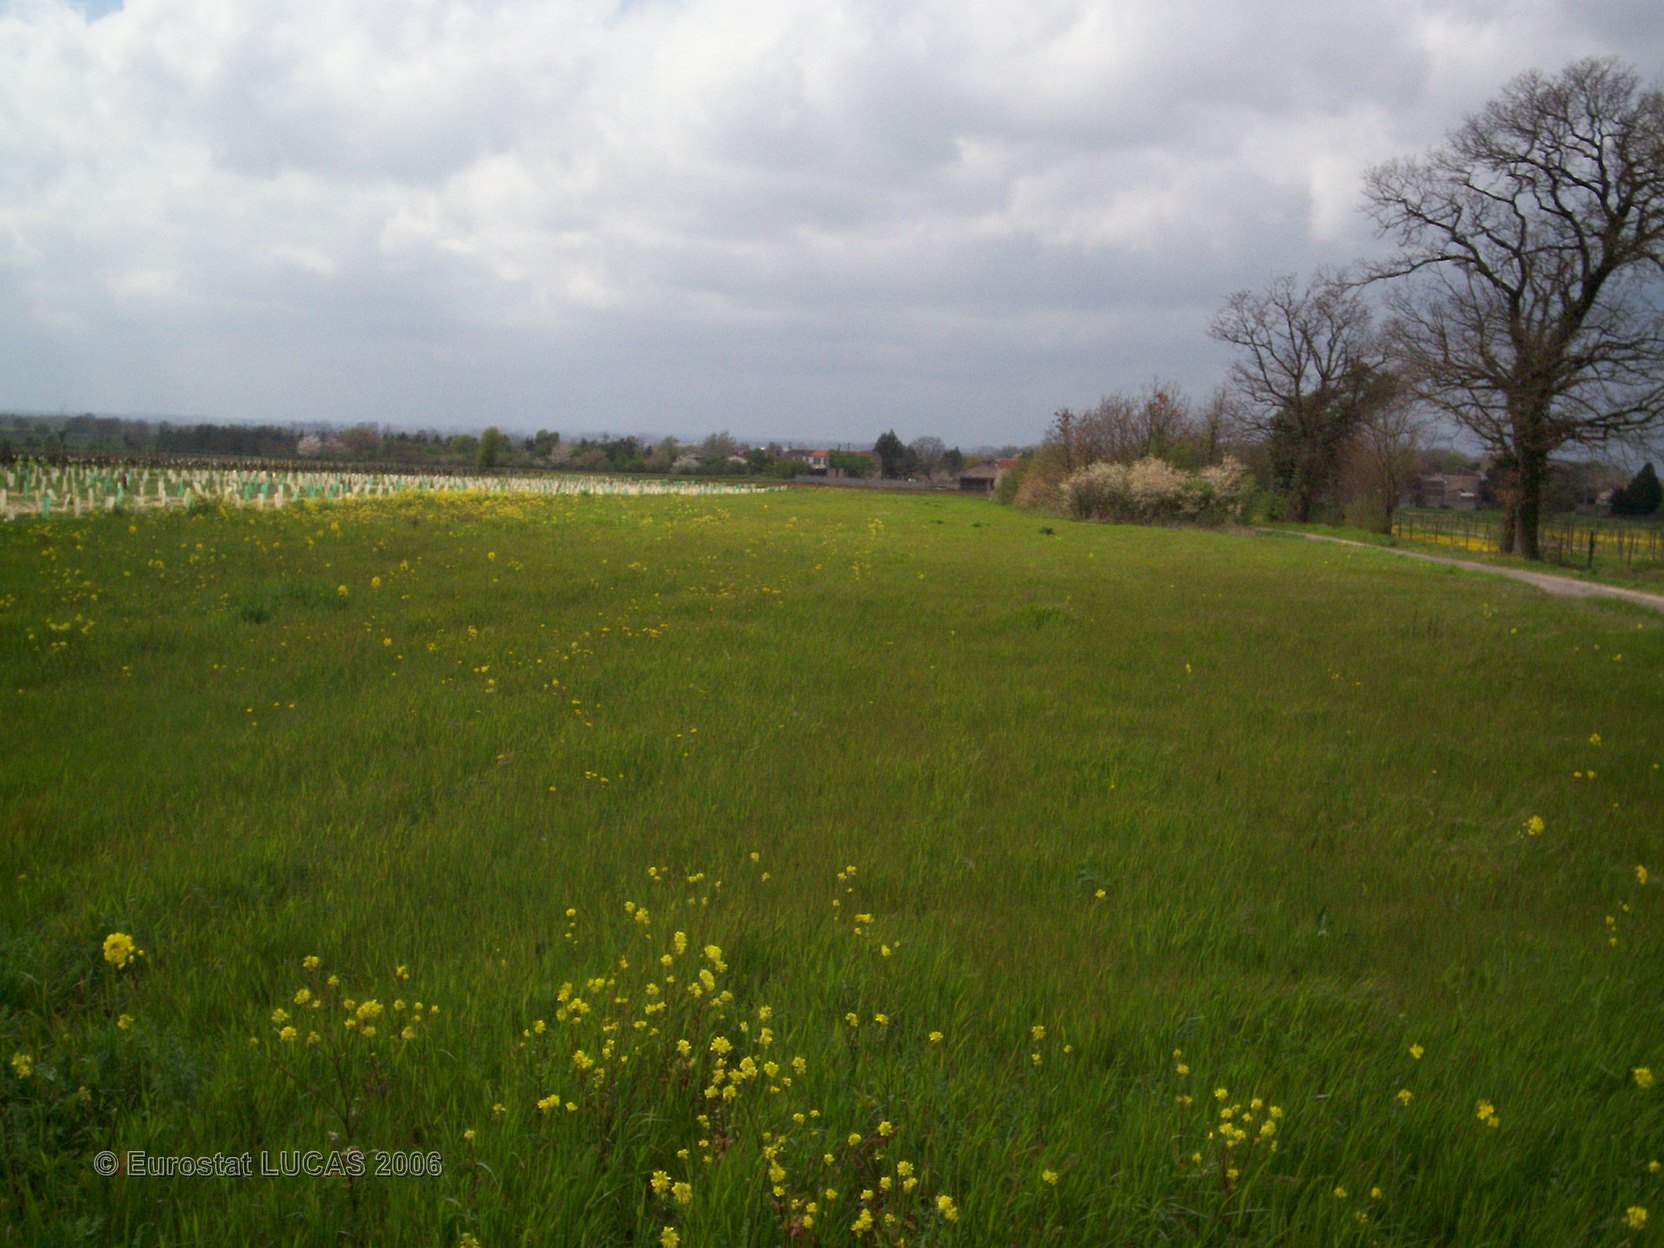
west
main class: Grassland
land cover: Grassland without tree/shrub cover
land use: Agriculture (excluding fallow land and kitchen gardens)
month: April
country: FR
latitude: 45.7367
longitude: -0.1854
